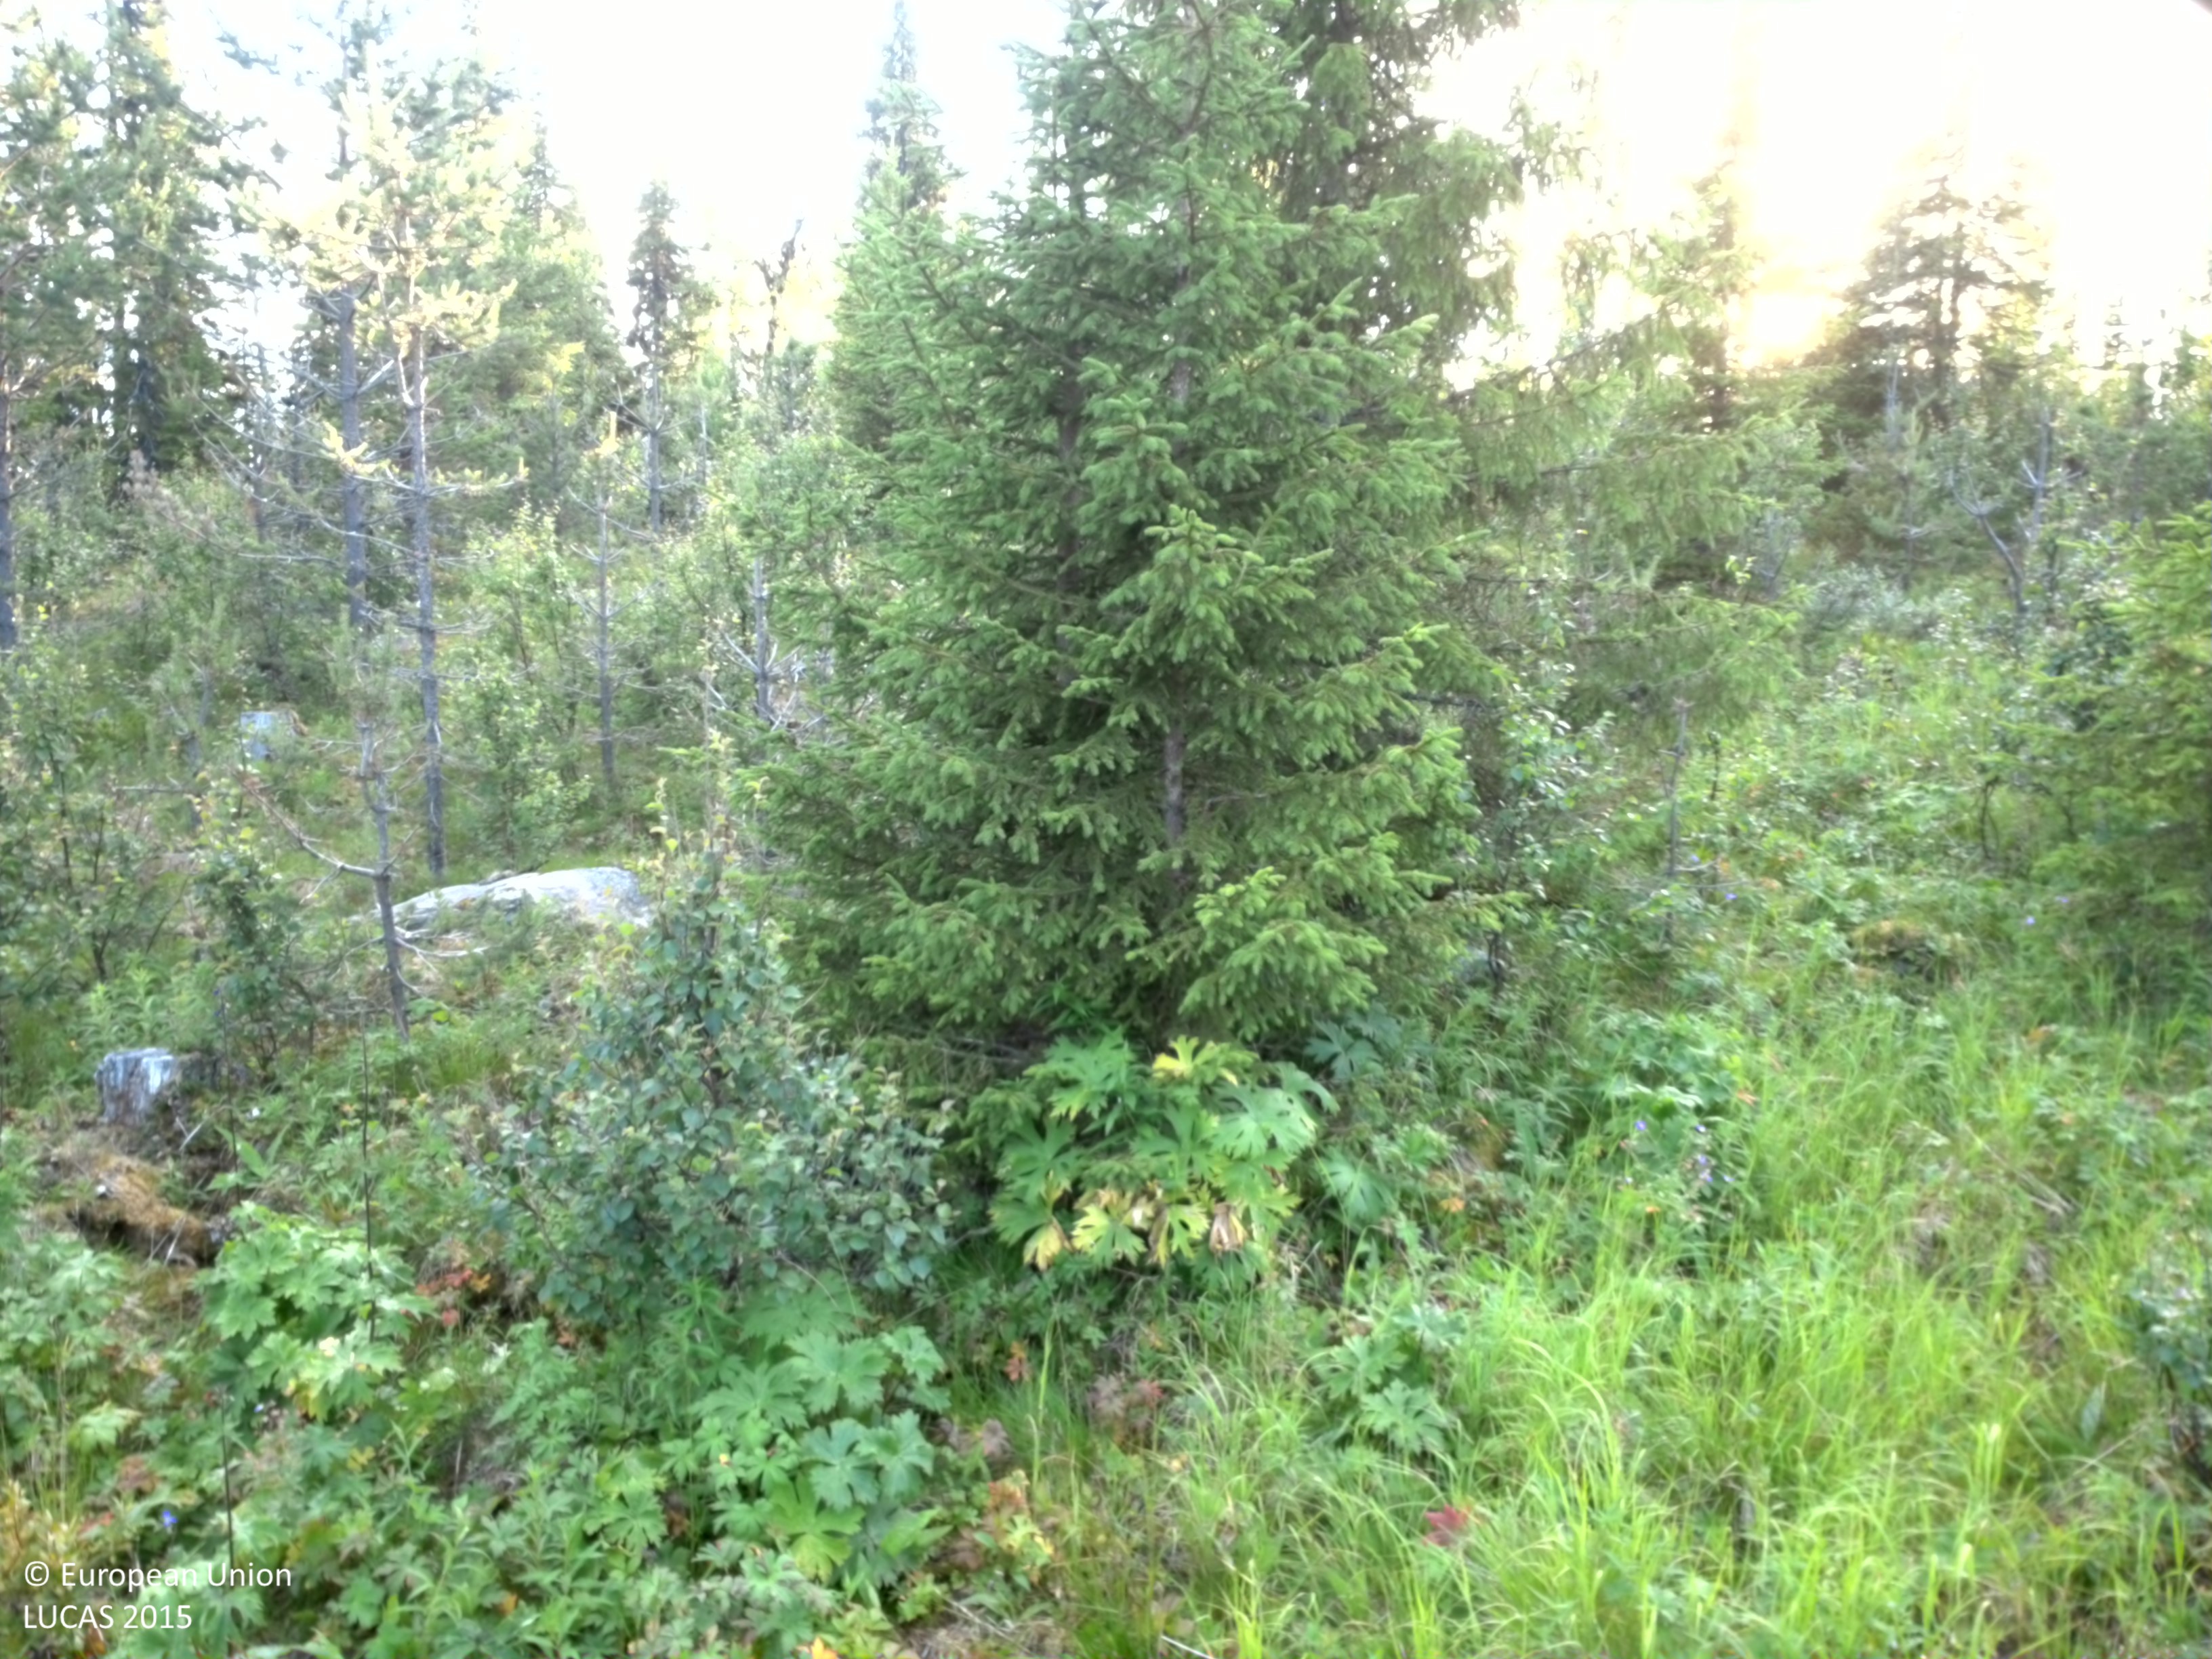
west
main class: Woodland
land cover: Other mixed woodland
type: boreal forest
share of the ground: 10 - 25 %
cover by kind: herbaceous plants 60 %, shrubs 20 %, coniferous forest trees 10 %, broadleaved forest trees 5 %, lichens and mosses 5 %
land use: Forestry
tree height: > 5 m
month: August
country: SE
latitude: 65.0714
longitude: 16.2800
